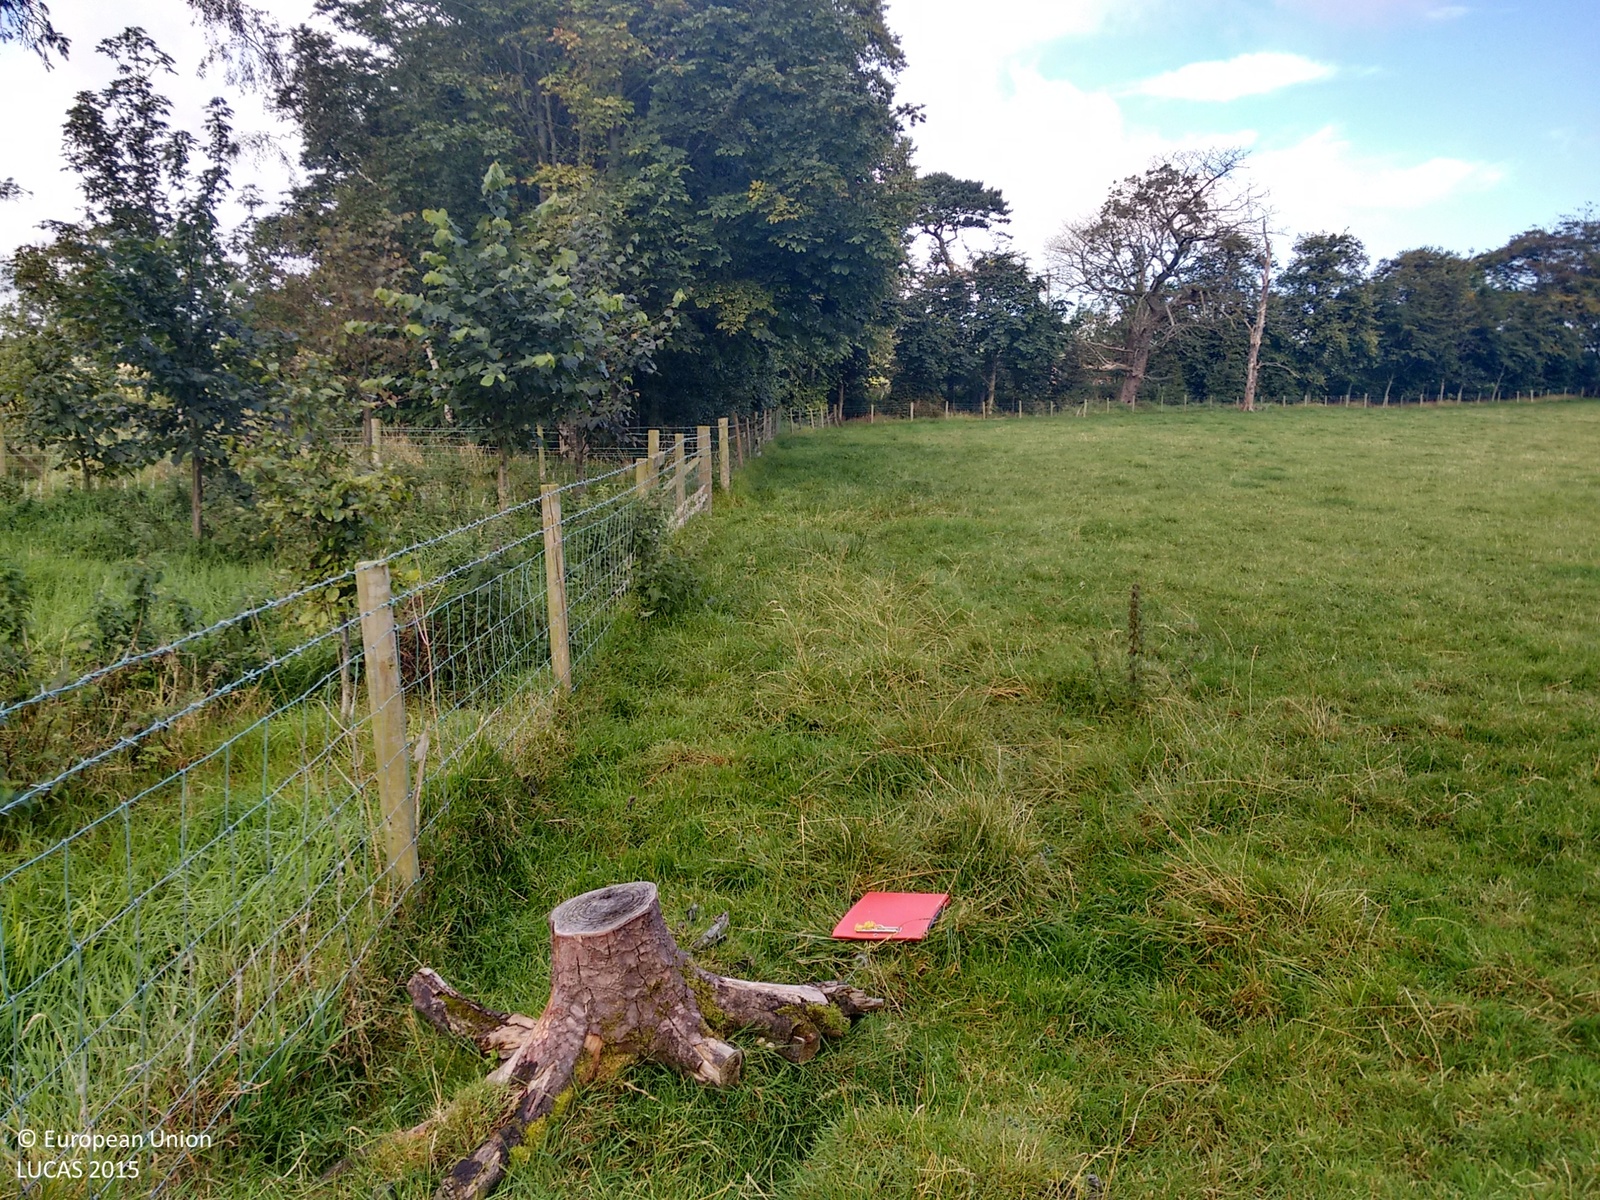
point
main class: Woodland
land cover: Spruce dominated mixed woodland
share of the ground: 25 - 50 %
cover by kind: herbaceous plants 60 %, coniferous forest trees 20 %, broadleaved forest trees 20 %
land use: Agriculture (excluding fallow land and kitchen gardens)
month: September
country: GB
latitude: 54.7435
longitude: -5.7768
